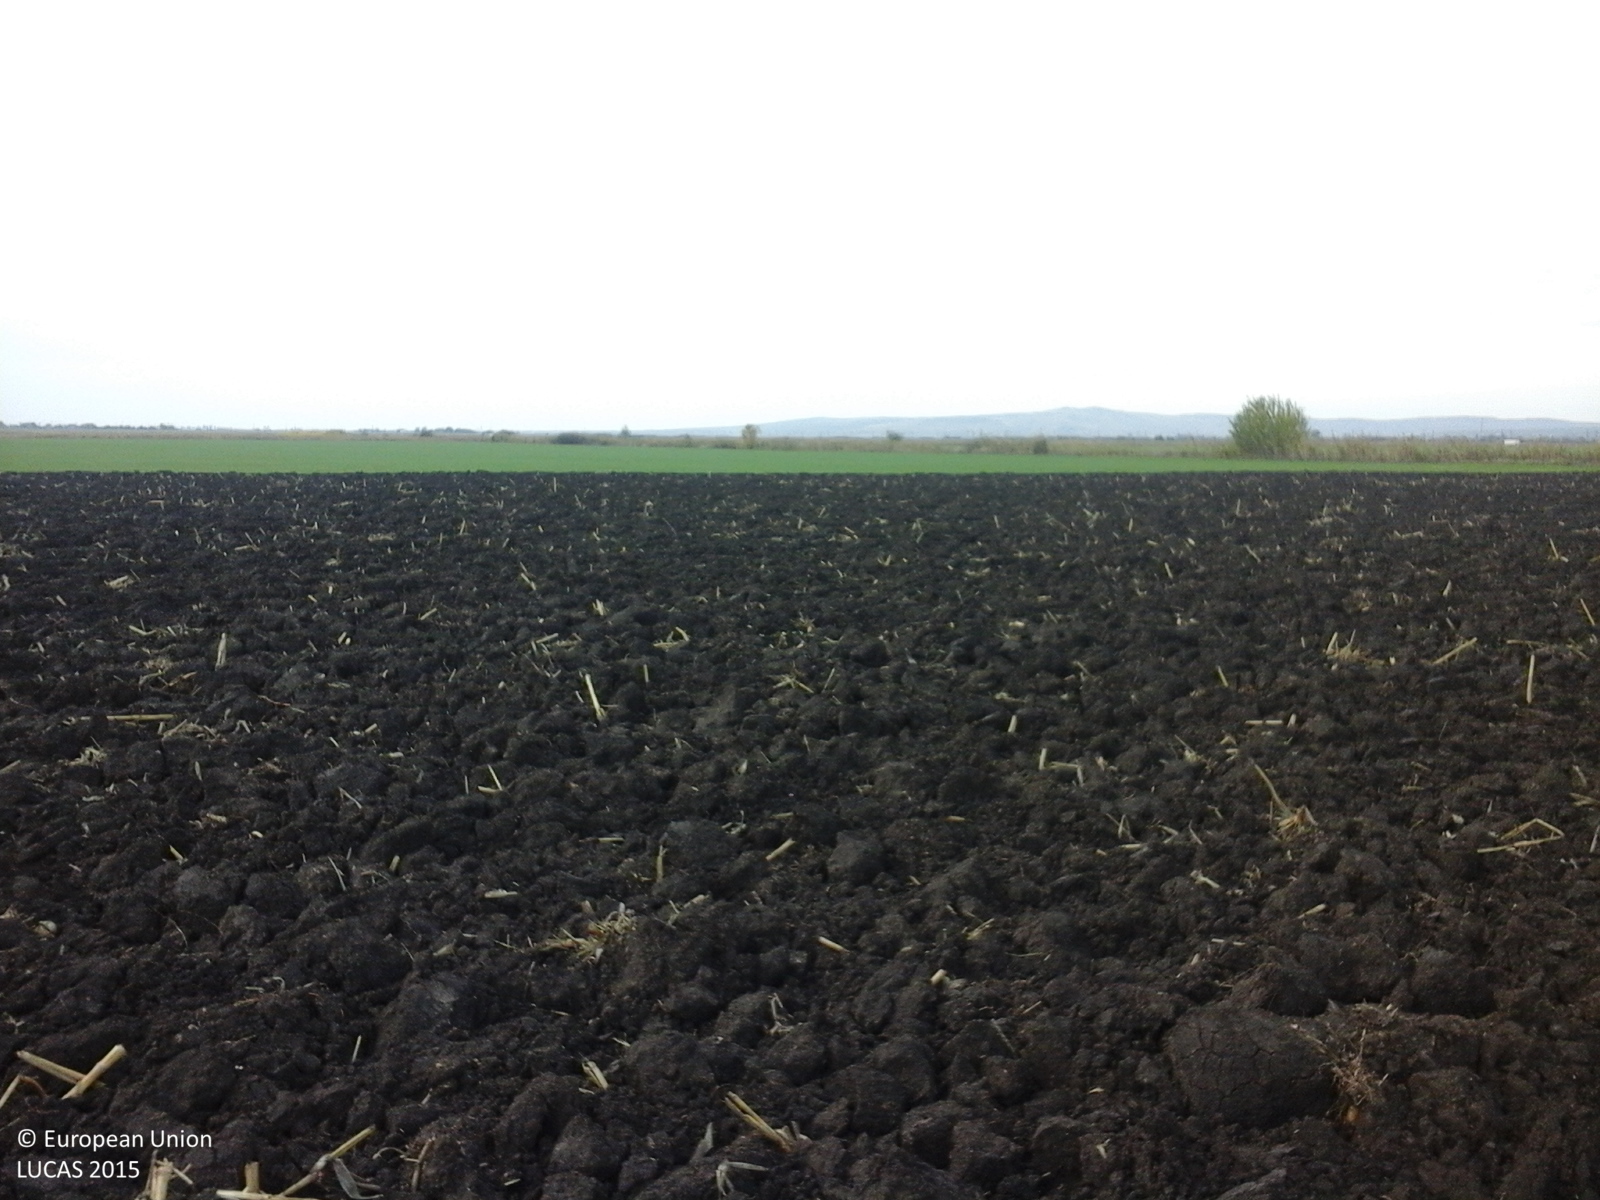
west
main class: Cropland
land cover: Maize
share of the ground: < 10 %
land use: Agriculture (excluding fallow land and kitchen gardens)
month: October
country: RO
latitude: 44.9570
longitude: 26.3290
